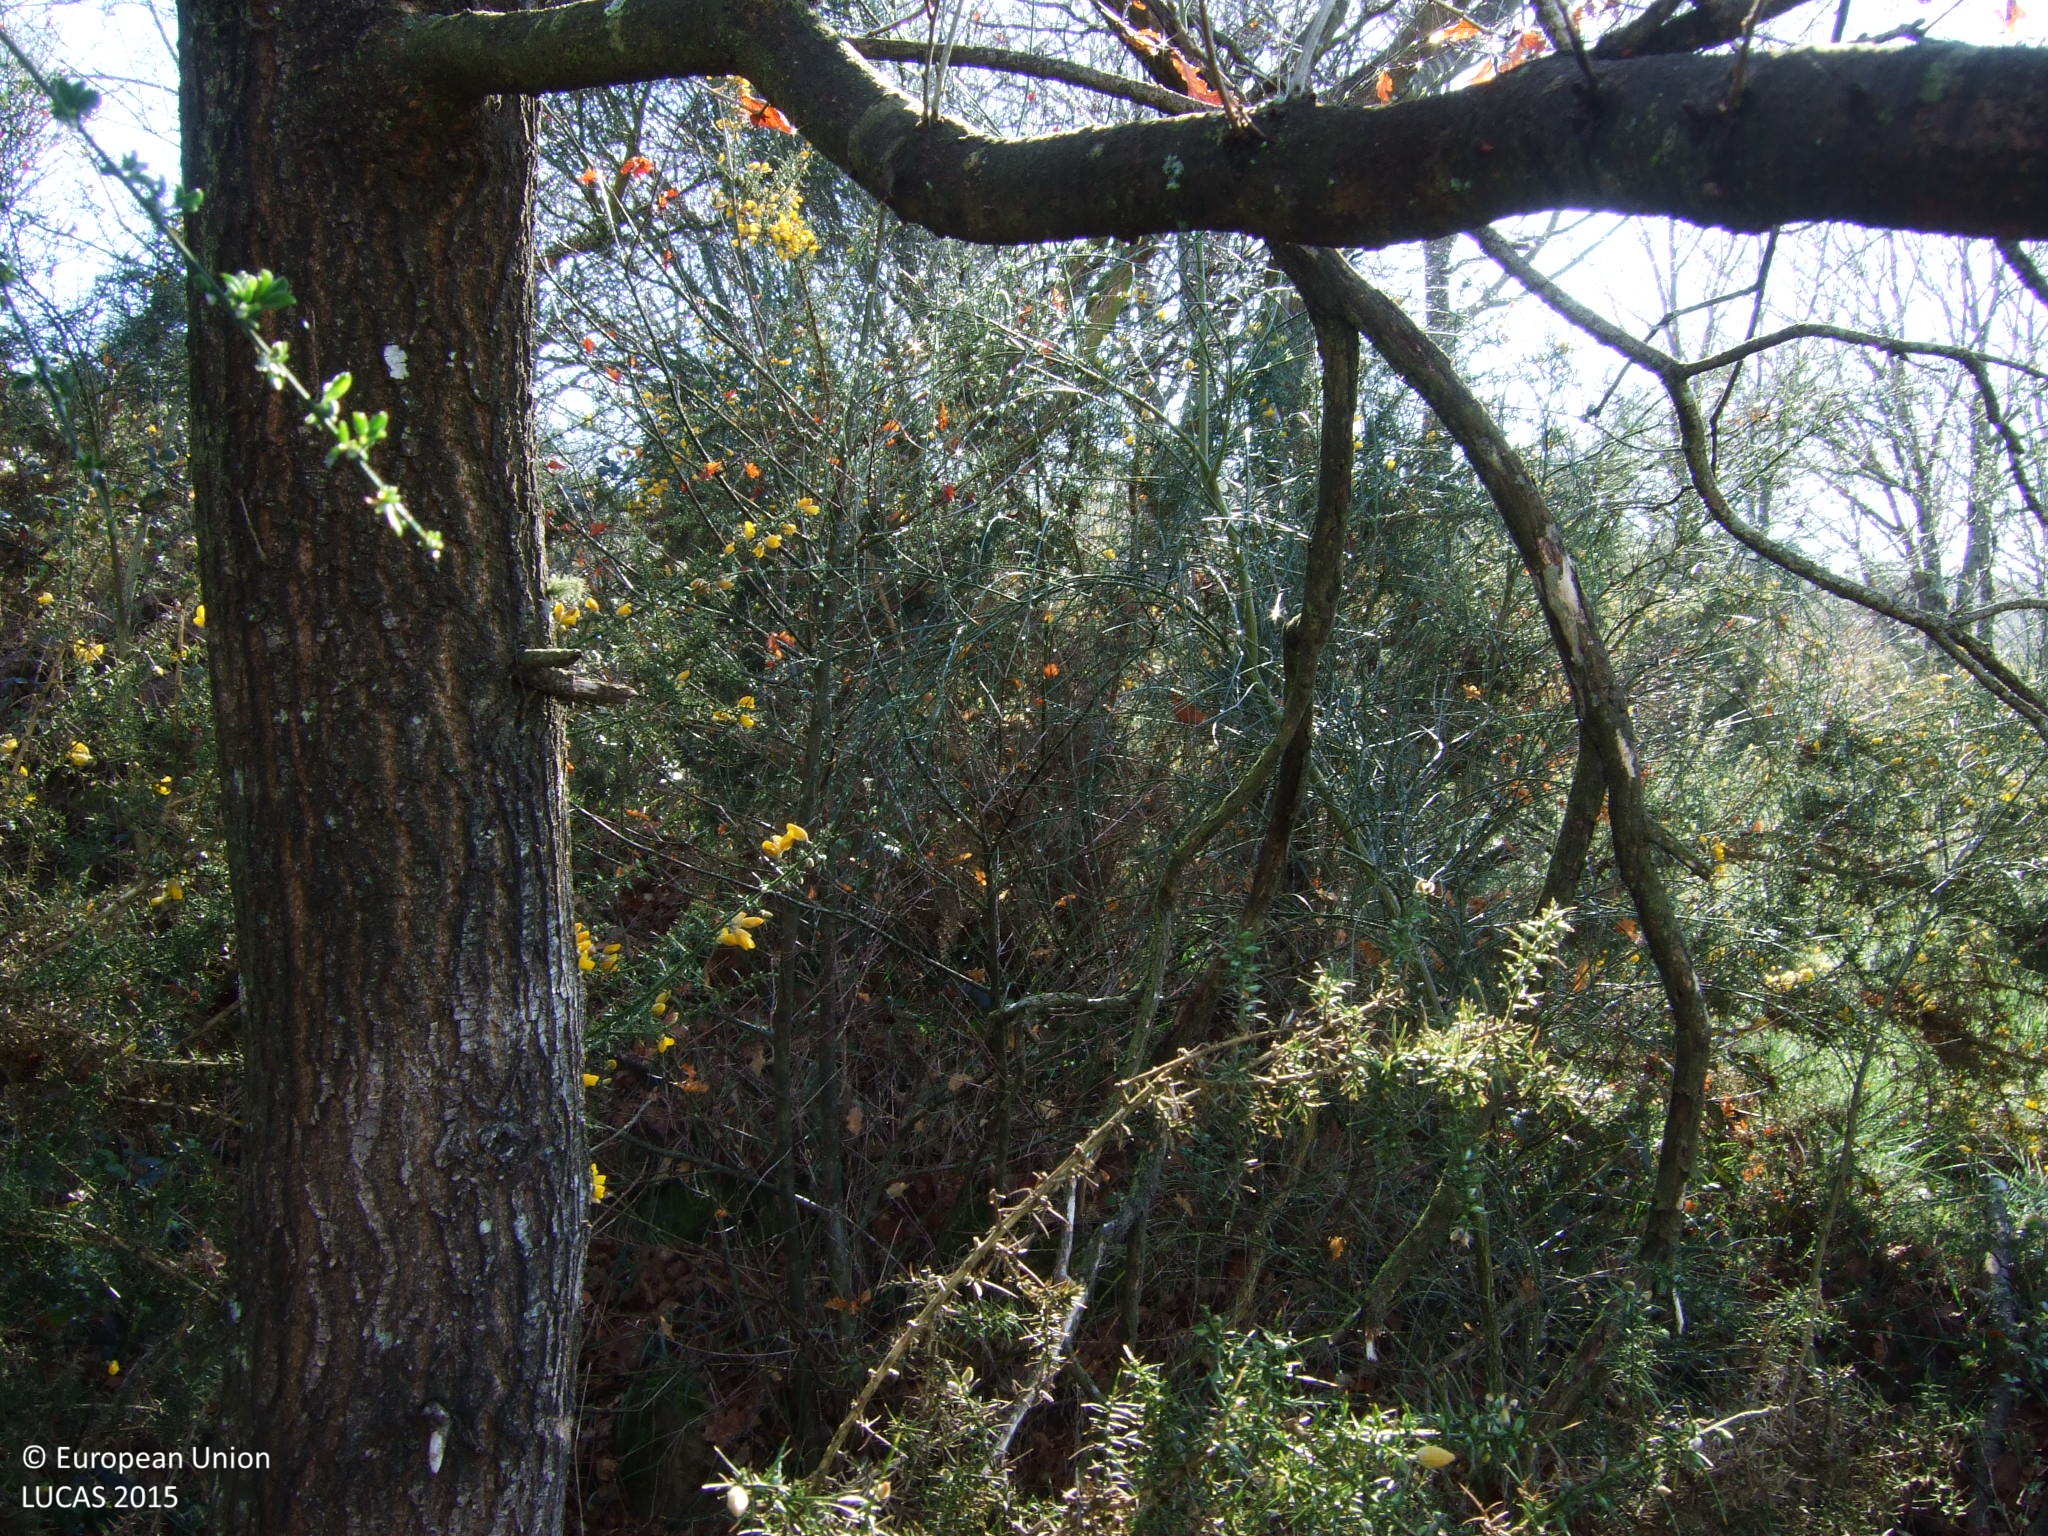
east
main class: Woodland
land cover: Broadleaved woodland
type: acidophilous oak and oak-birch forest
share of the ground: 10 - 25 %
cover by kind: shrubs 50 %, herbaceous plants 30 %, broadleaved forest trees 20 %
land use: Semi-natural and natural areas not in use
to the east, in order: Broadleaved woodland; Dry stone walls; Shruby margins; Tracks; Groves; Shrubland without tree cover; Abandoned hedges; Grassland without tree/shrub cover; Other bare soil; Durum wheat
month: April
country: ES
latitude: 42.7617
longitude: -7.7868
